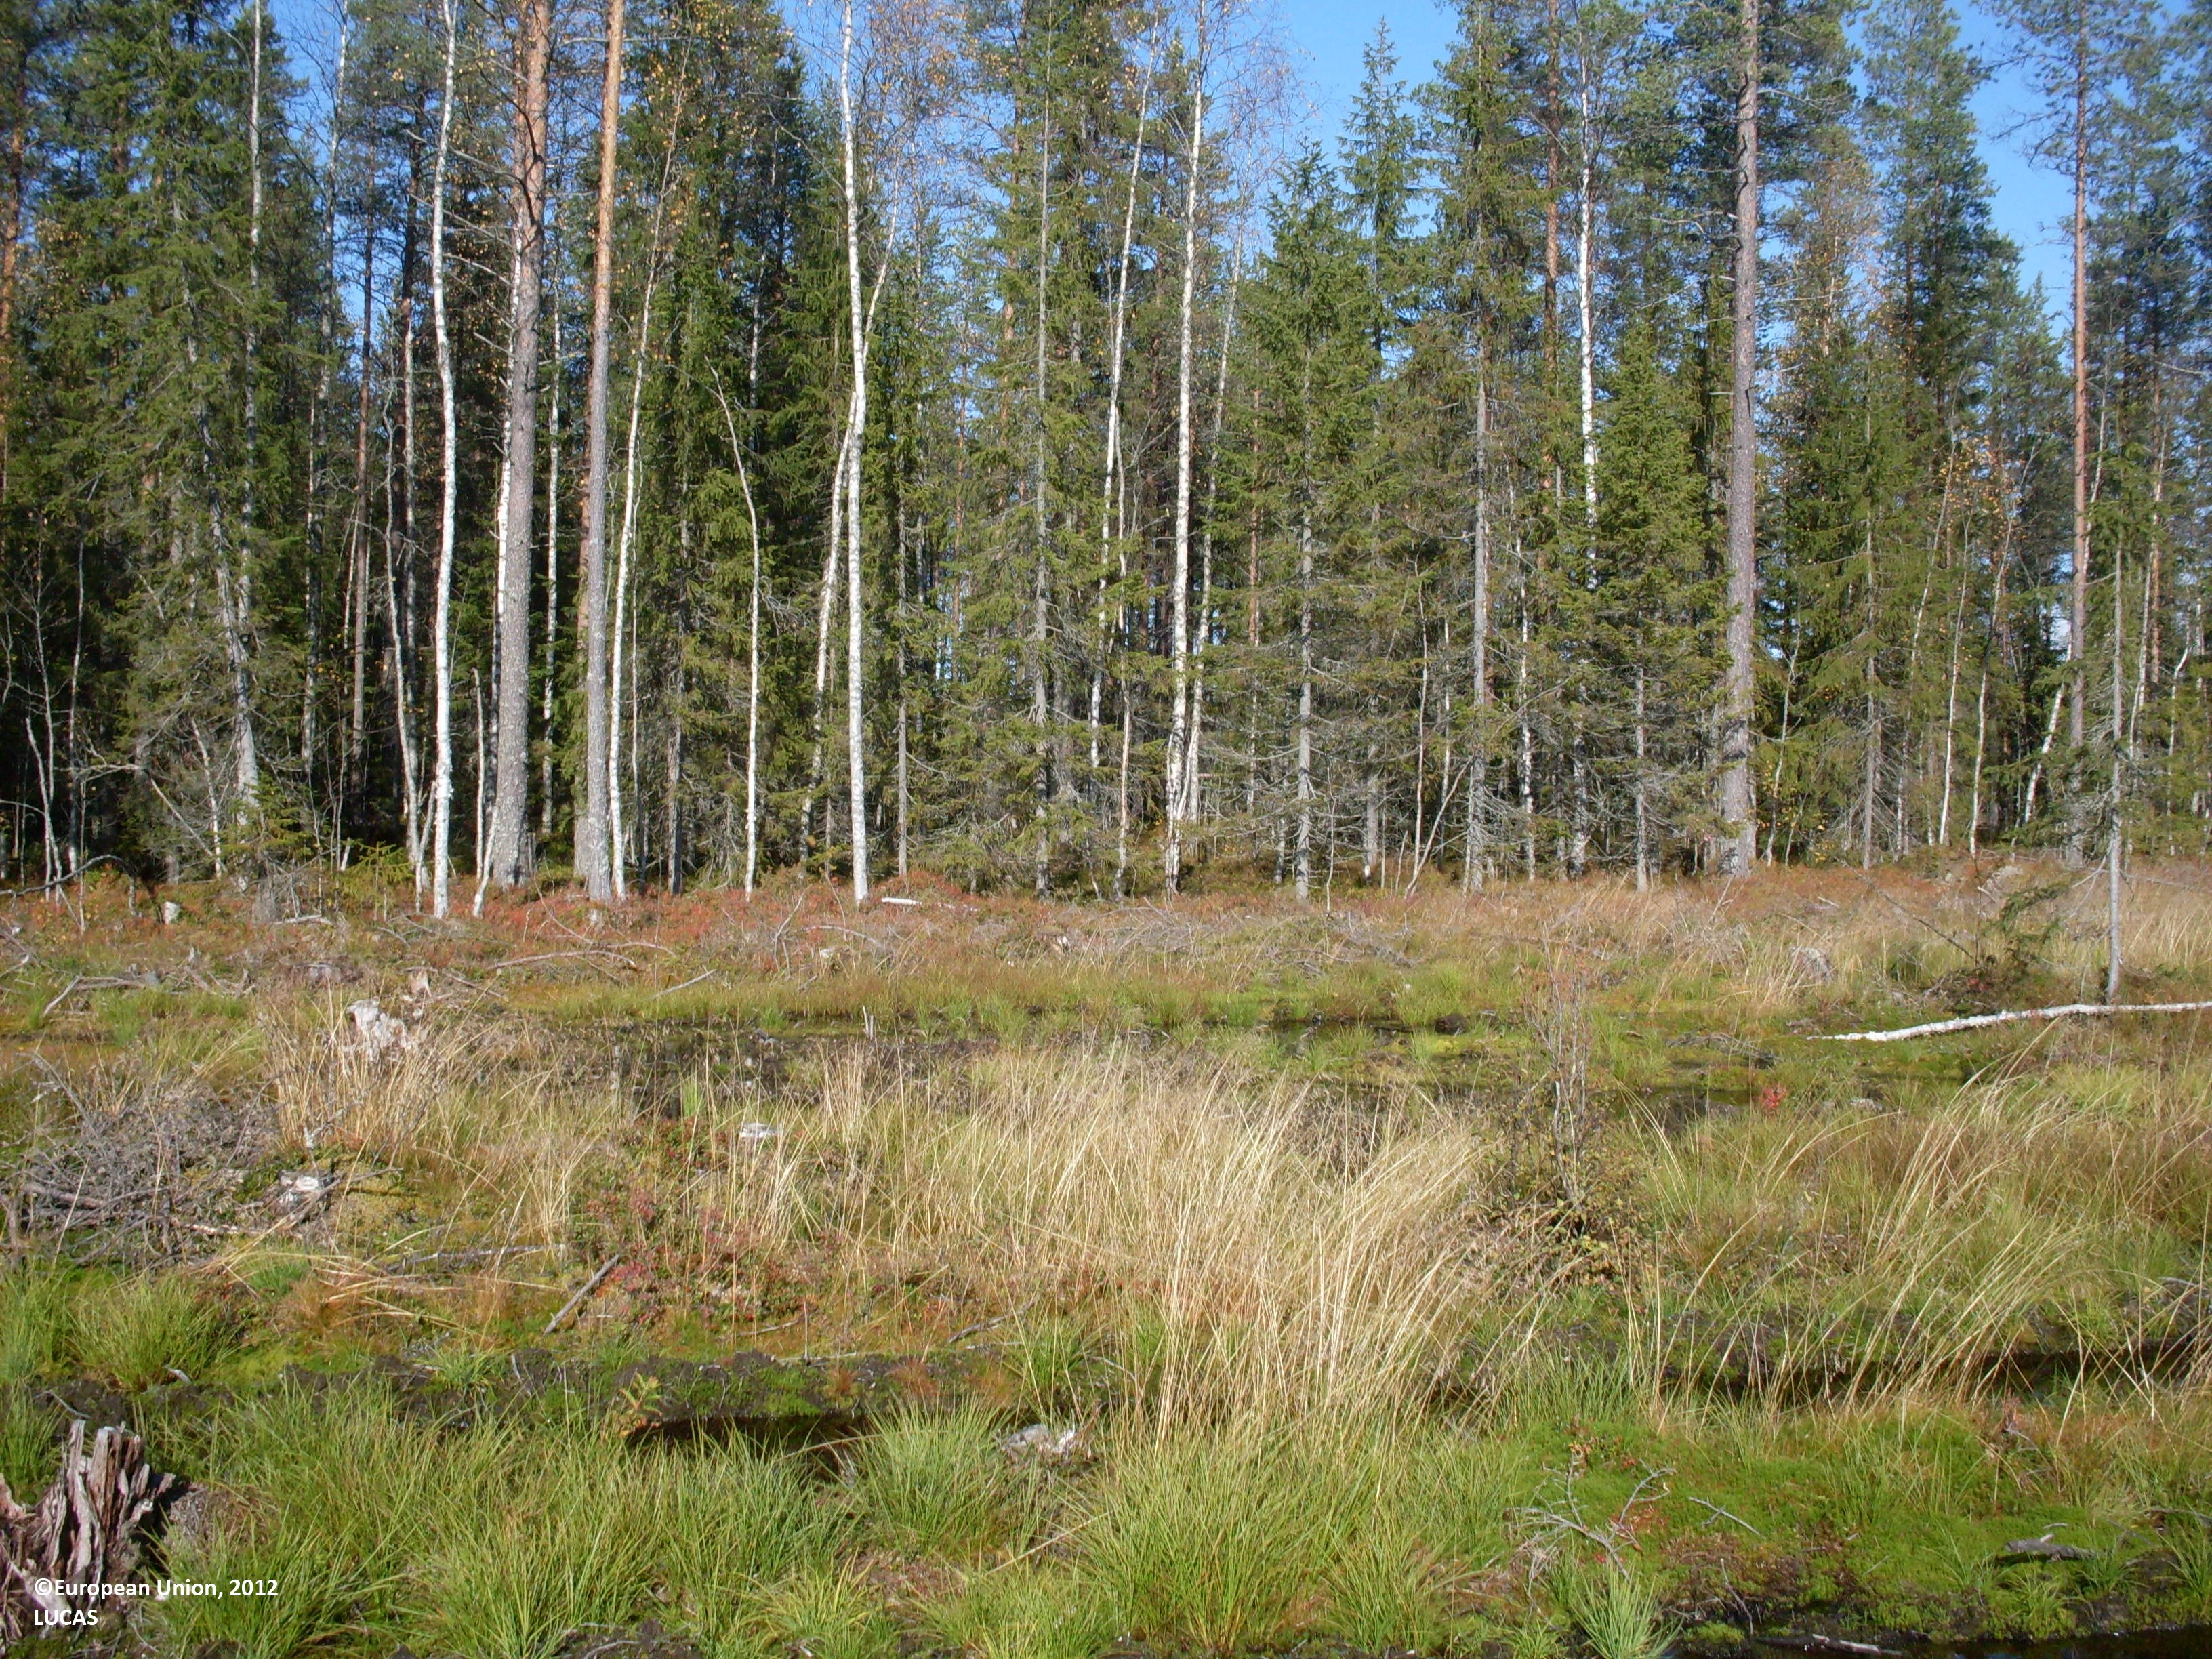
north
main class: Woodland
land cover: Pine dominated mixed woodland
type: boreal forest
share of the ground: 50 - 75 %
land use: Forestry
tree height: > 5 m
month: September
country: FI
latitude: 64.3059
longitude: 28.4725
